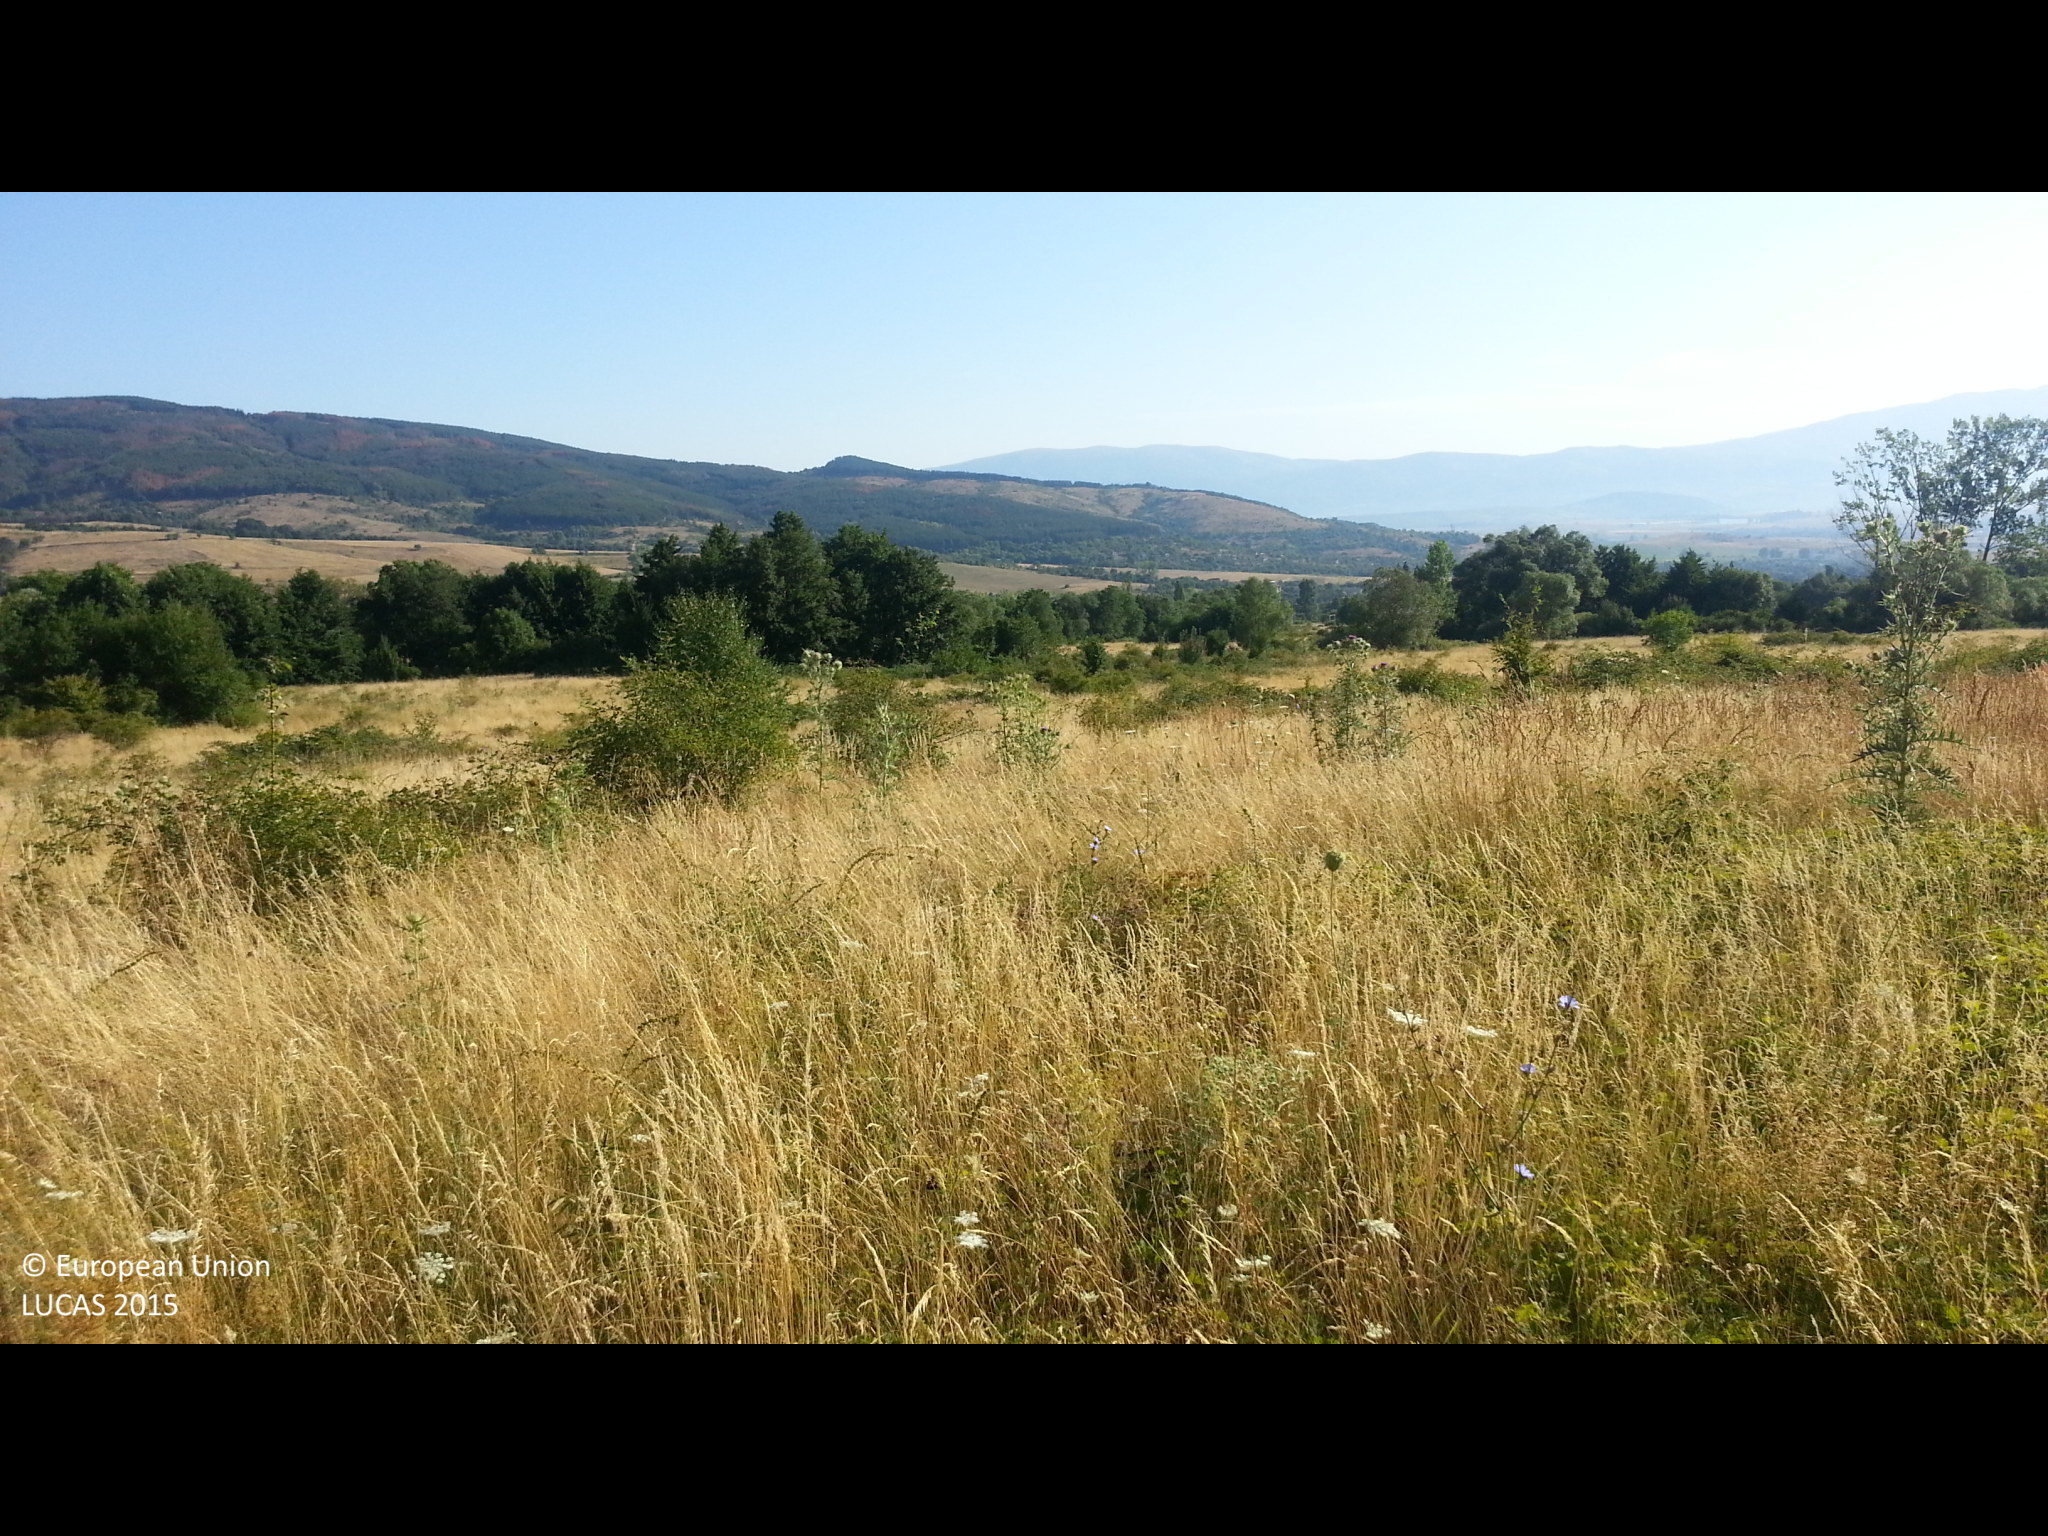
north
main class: Grassland
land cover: Grassland without tree/shrub cover
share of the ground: > 75 %
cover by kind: herbaceous plants 95 %, shrubs 5 %
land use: Semi-natural and natural areas not in use
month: August
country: BG
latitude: 42.2633
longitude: 22.6163
